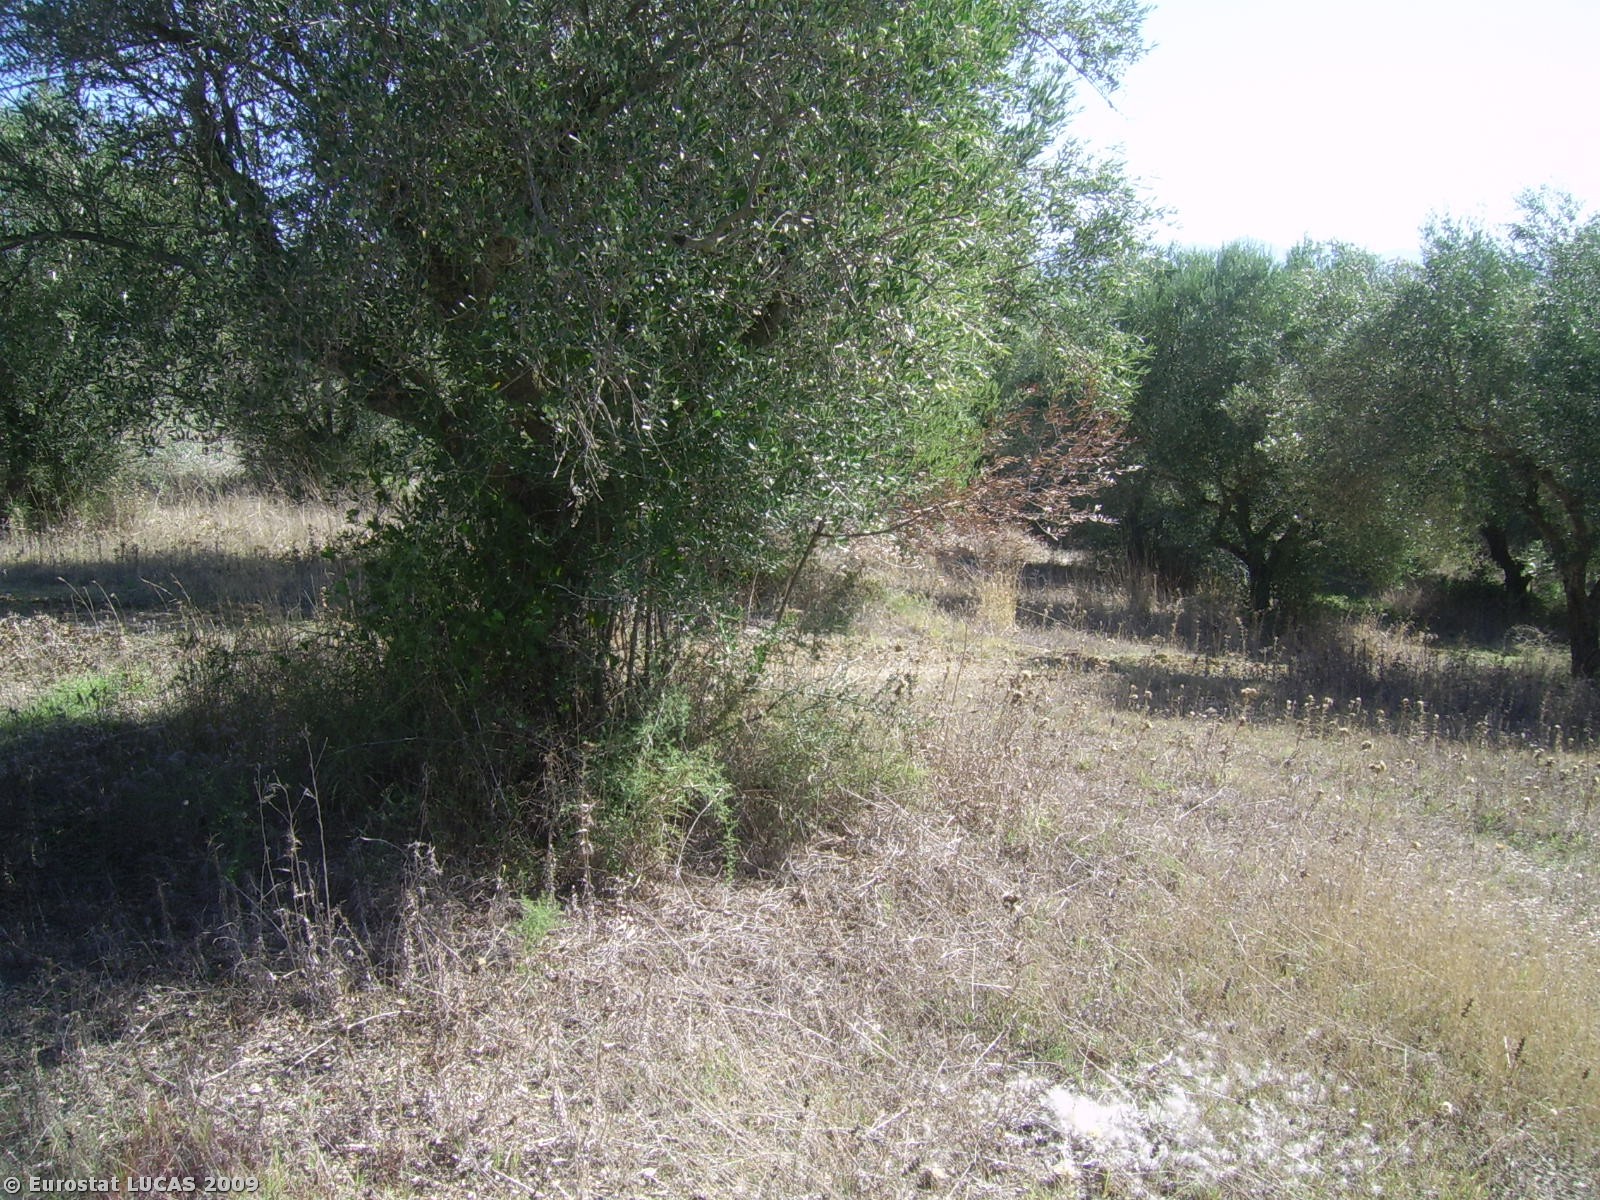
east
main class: Cropland
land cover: Olive groves
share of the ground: 50 - 75 %
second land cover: Grassland with sparse tree/shrub cover
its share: 50 - 75 %
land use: Agriculture (excluding fallow land and kitchen gardens)
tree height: > 5 m
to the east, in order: Olive groves; Grassland with sparse tree/shrub cover; Fences; Mixed cereals for fodder; Grassland without tree/shrub cover; Tracks; Common wheat
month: October
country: GR
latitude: 37.9892
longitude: 21.4285
